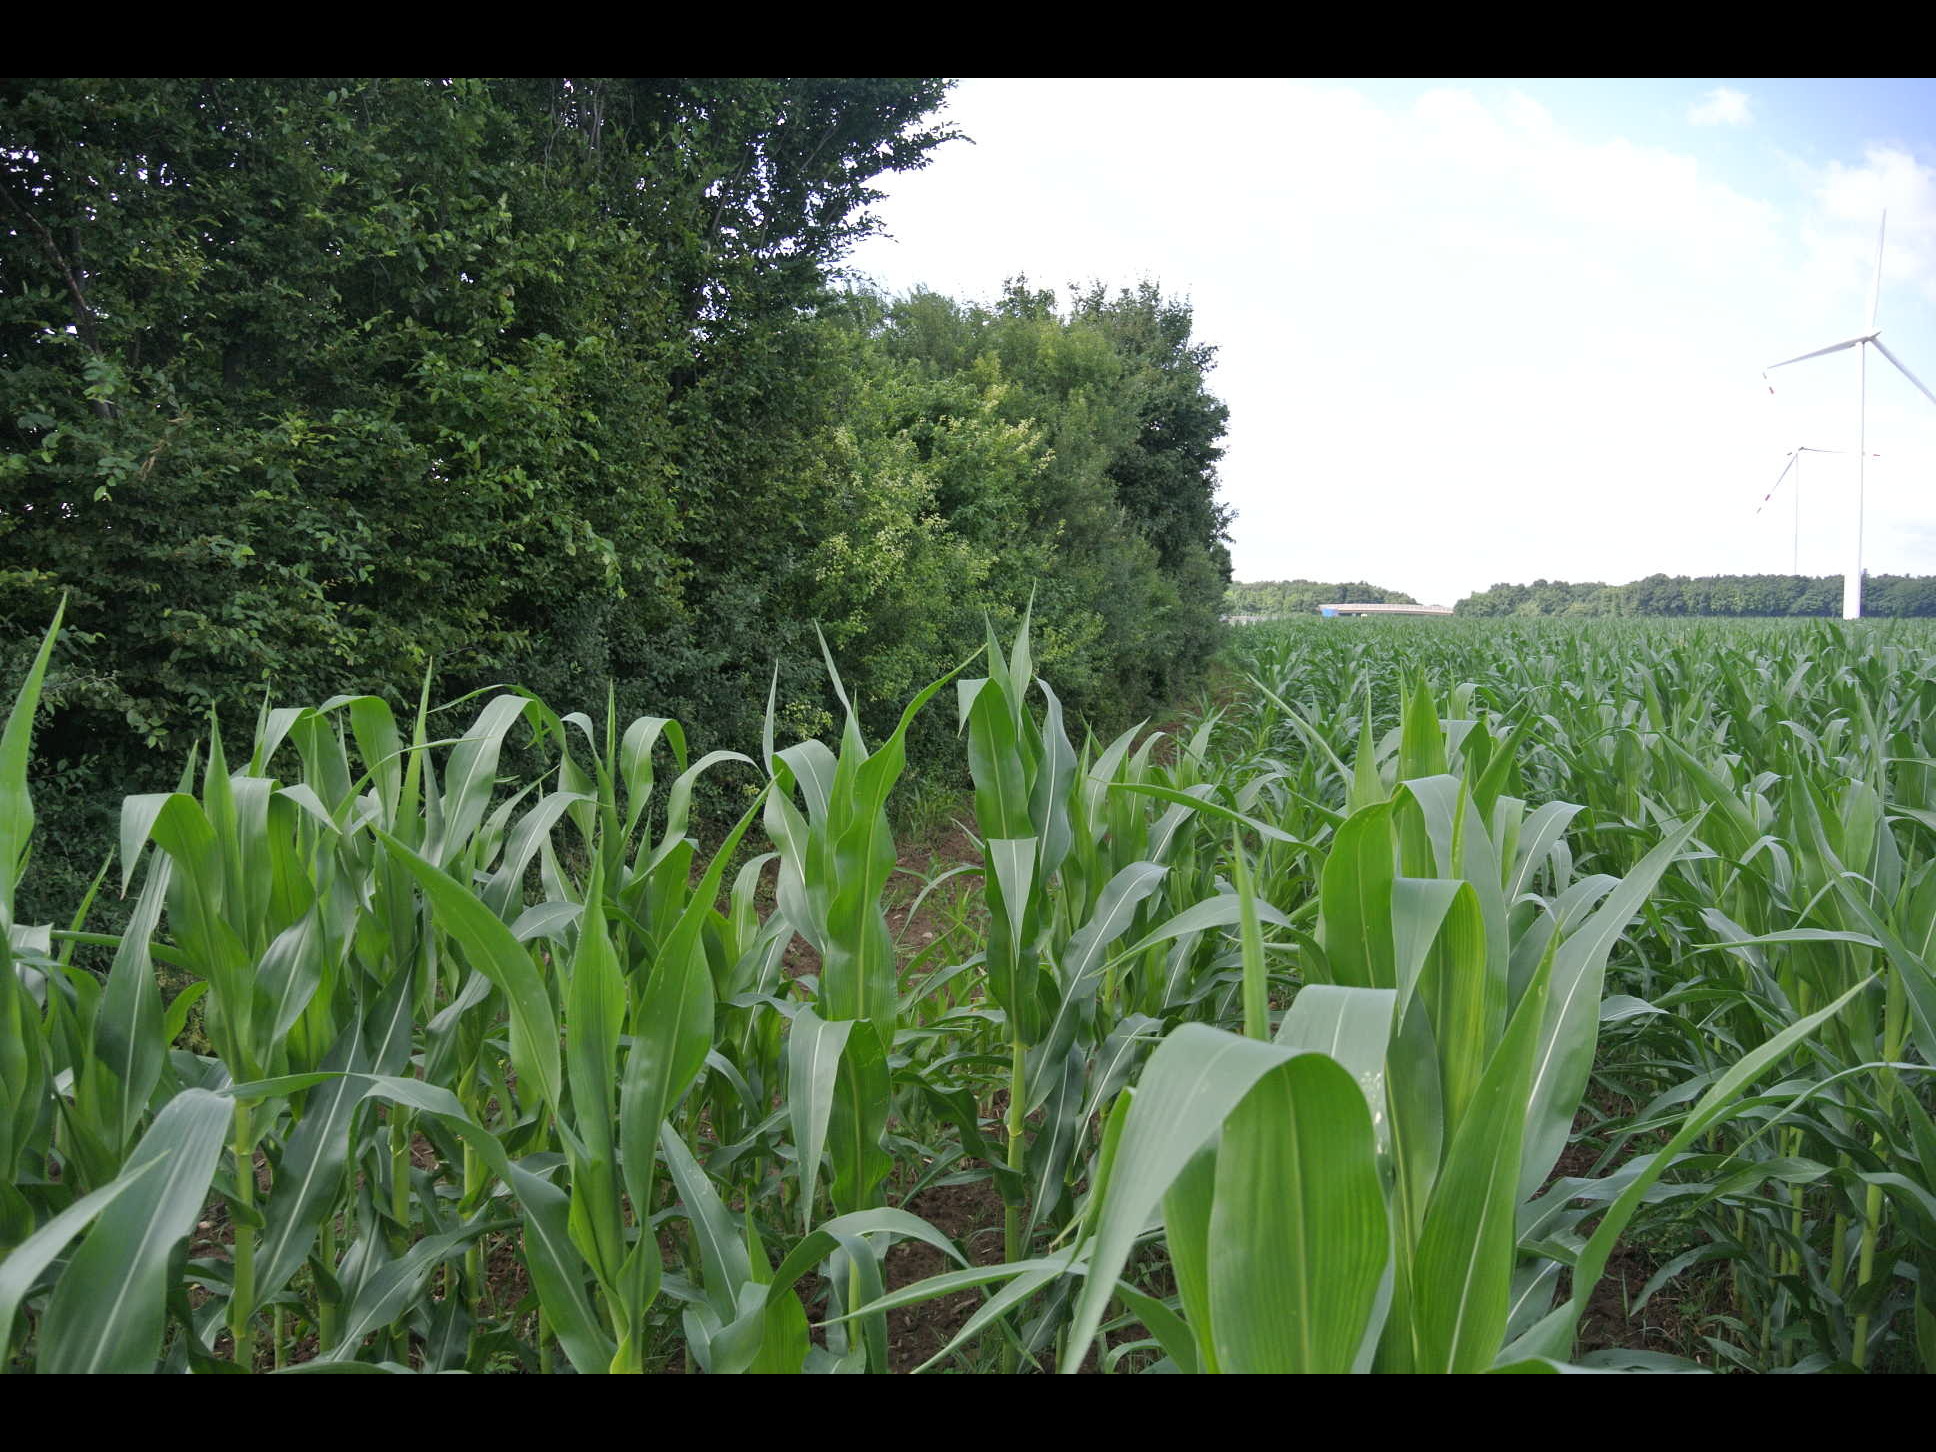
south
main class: Cropland
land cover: Maize
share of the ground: > 75 %
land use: Agriculture (excluding fallow land and kitchen gardens)
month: July
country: AT
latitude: 47.7655
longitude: 16.4219
